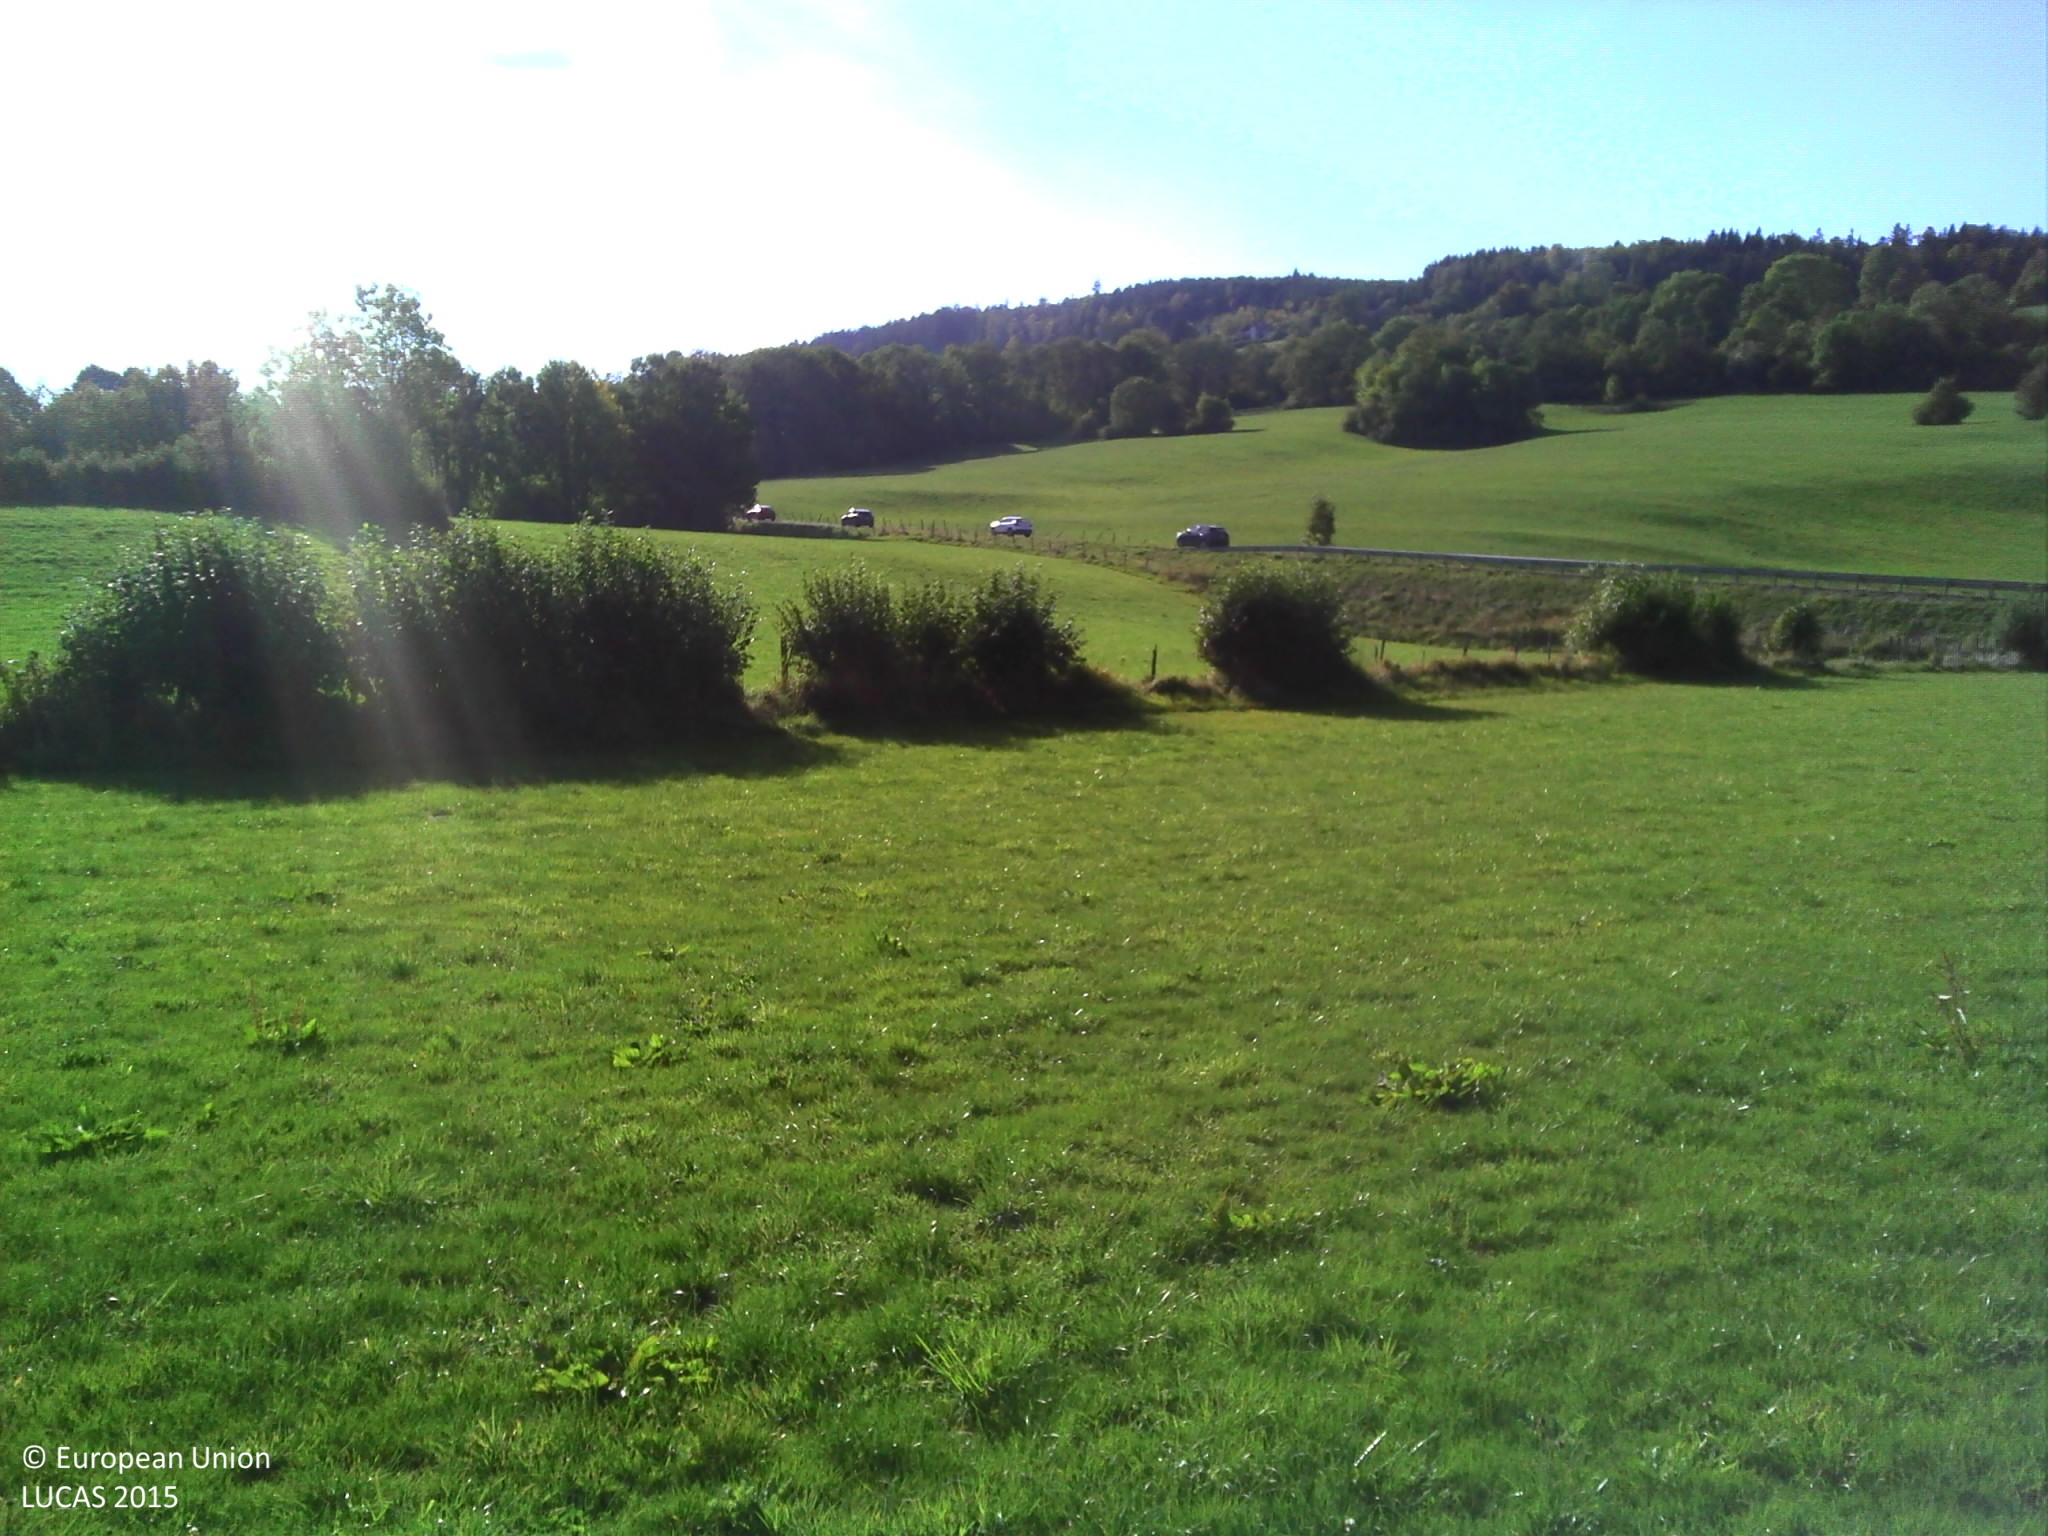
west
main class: Grassland
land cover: Grassland without tree/shrub cover
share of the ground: > 75 %
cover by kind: herbaceous plants 100 %
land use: Agriculture (excluding fallow land and kitchen gardens)
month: September
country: FR
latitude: 47.2598
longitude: 6.8436
